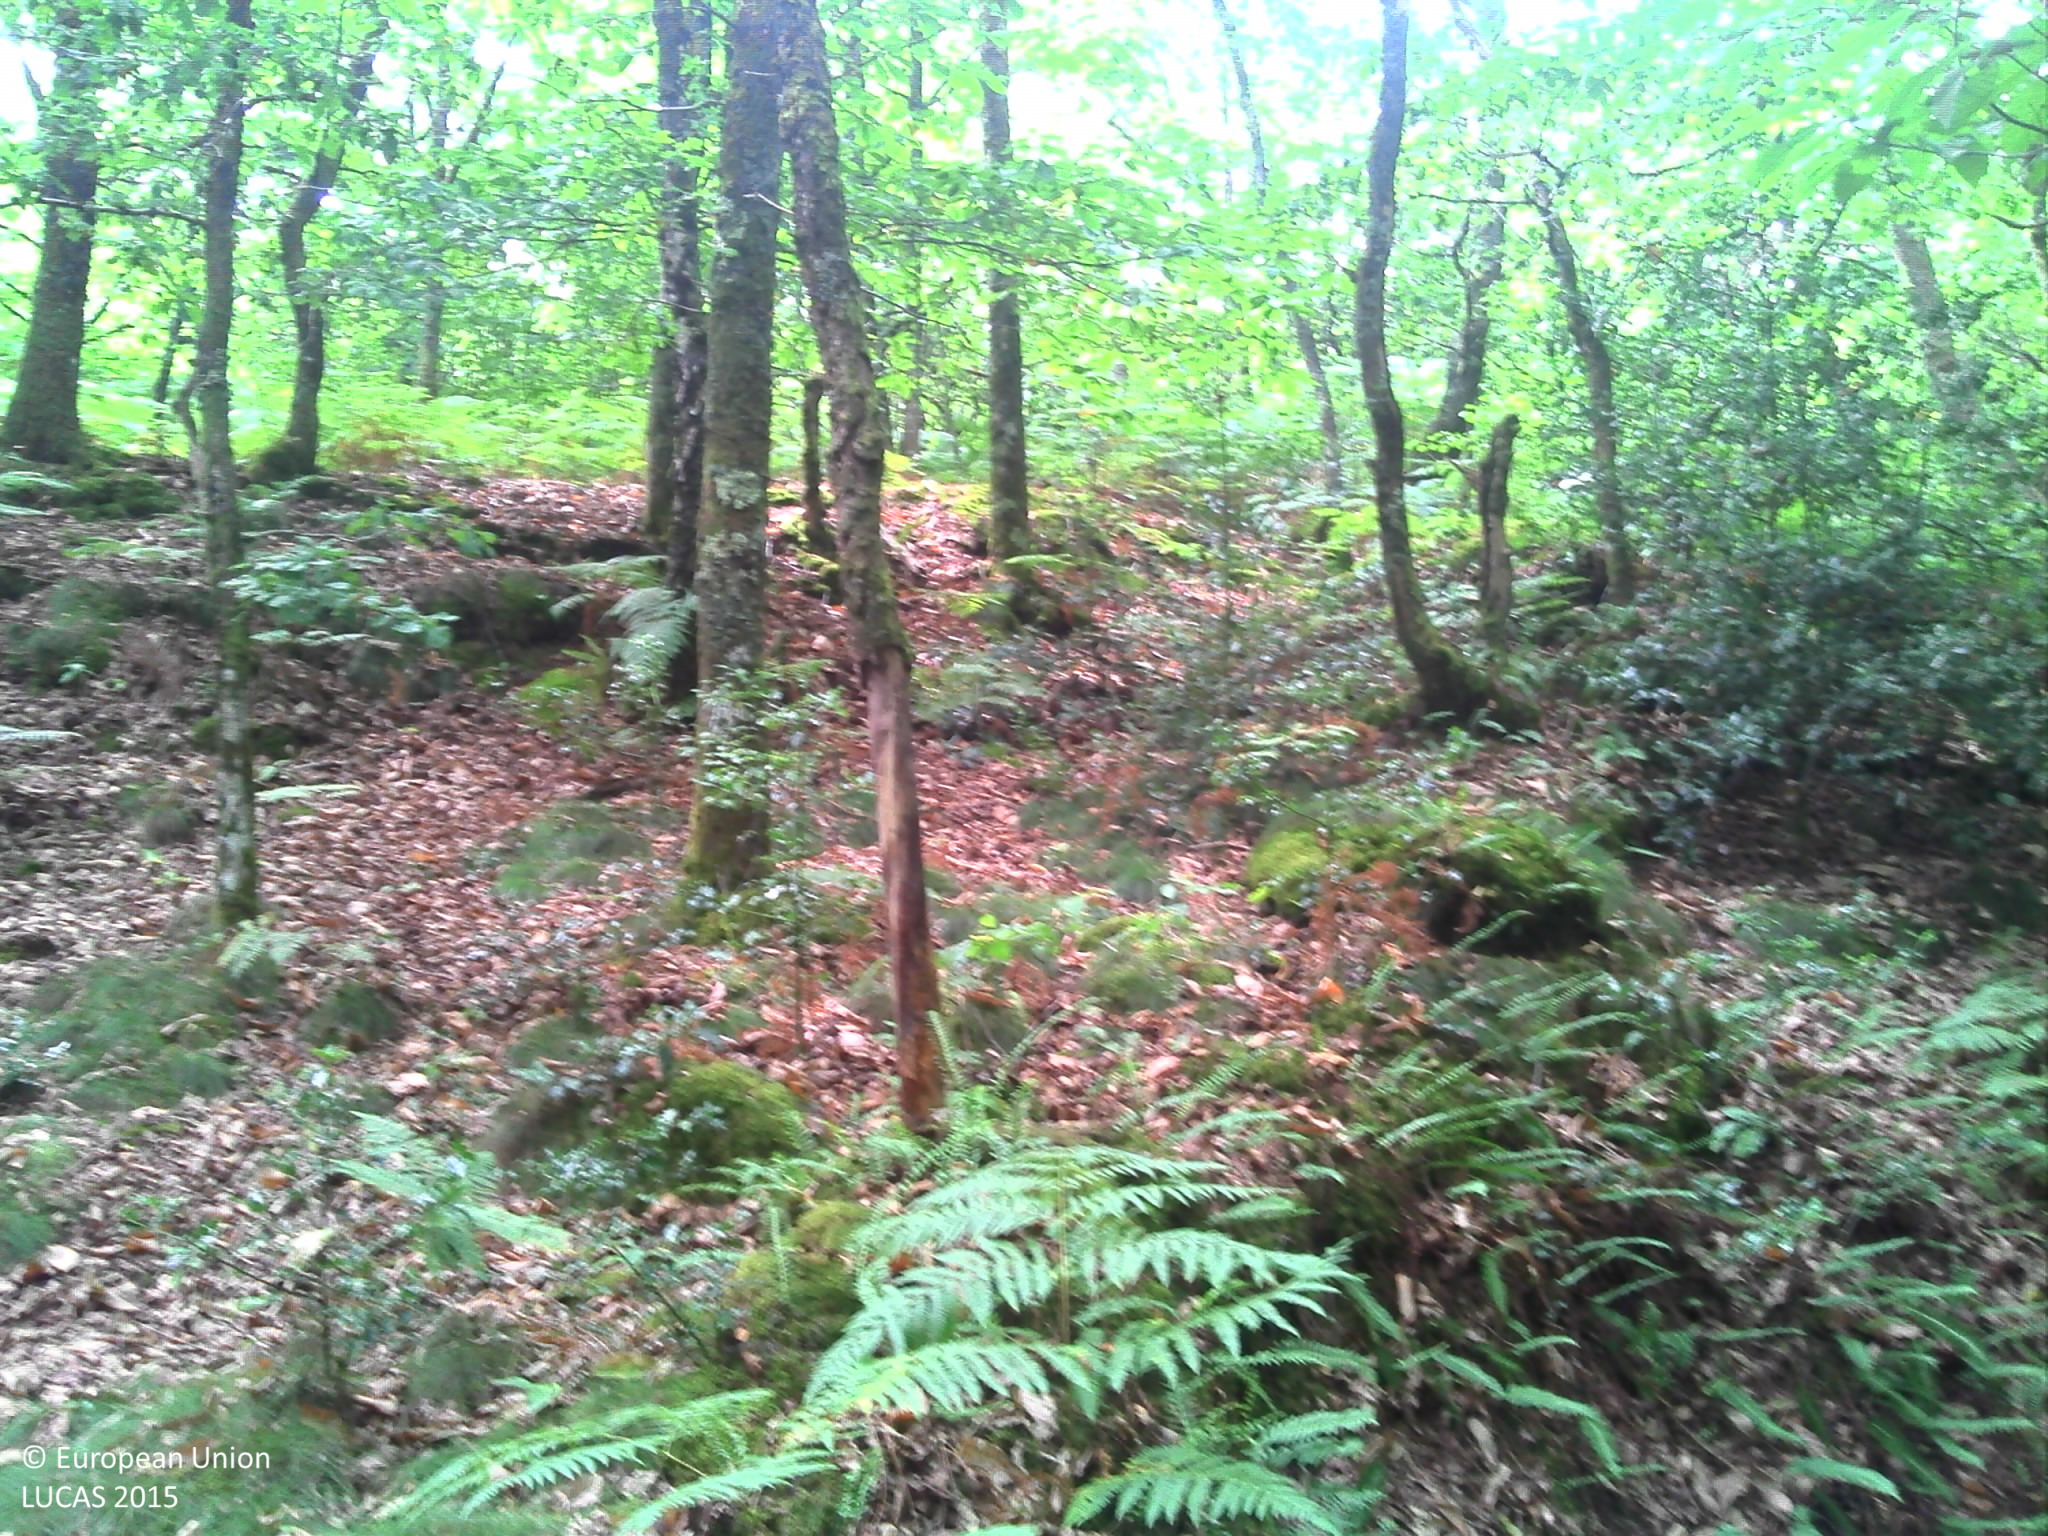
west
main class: Woodland
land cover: Broadleaved woodland
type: acidophilous oak and oak-birch forest
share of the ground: > 75 %
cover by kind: broadleaved forest trees 80 %, shrubs 10 %, herbaceous plants 5 %, lichens and mosses 5 %
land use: Forestry
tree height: > 5 m
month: August
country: FR
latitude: 46.2835
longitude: 1.7243
